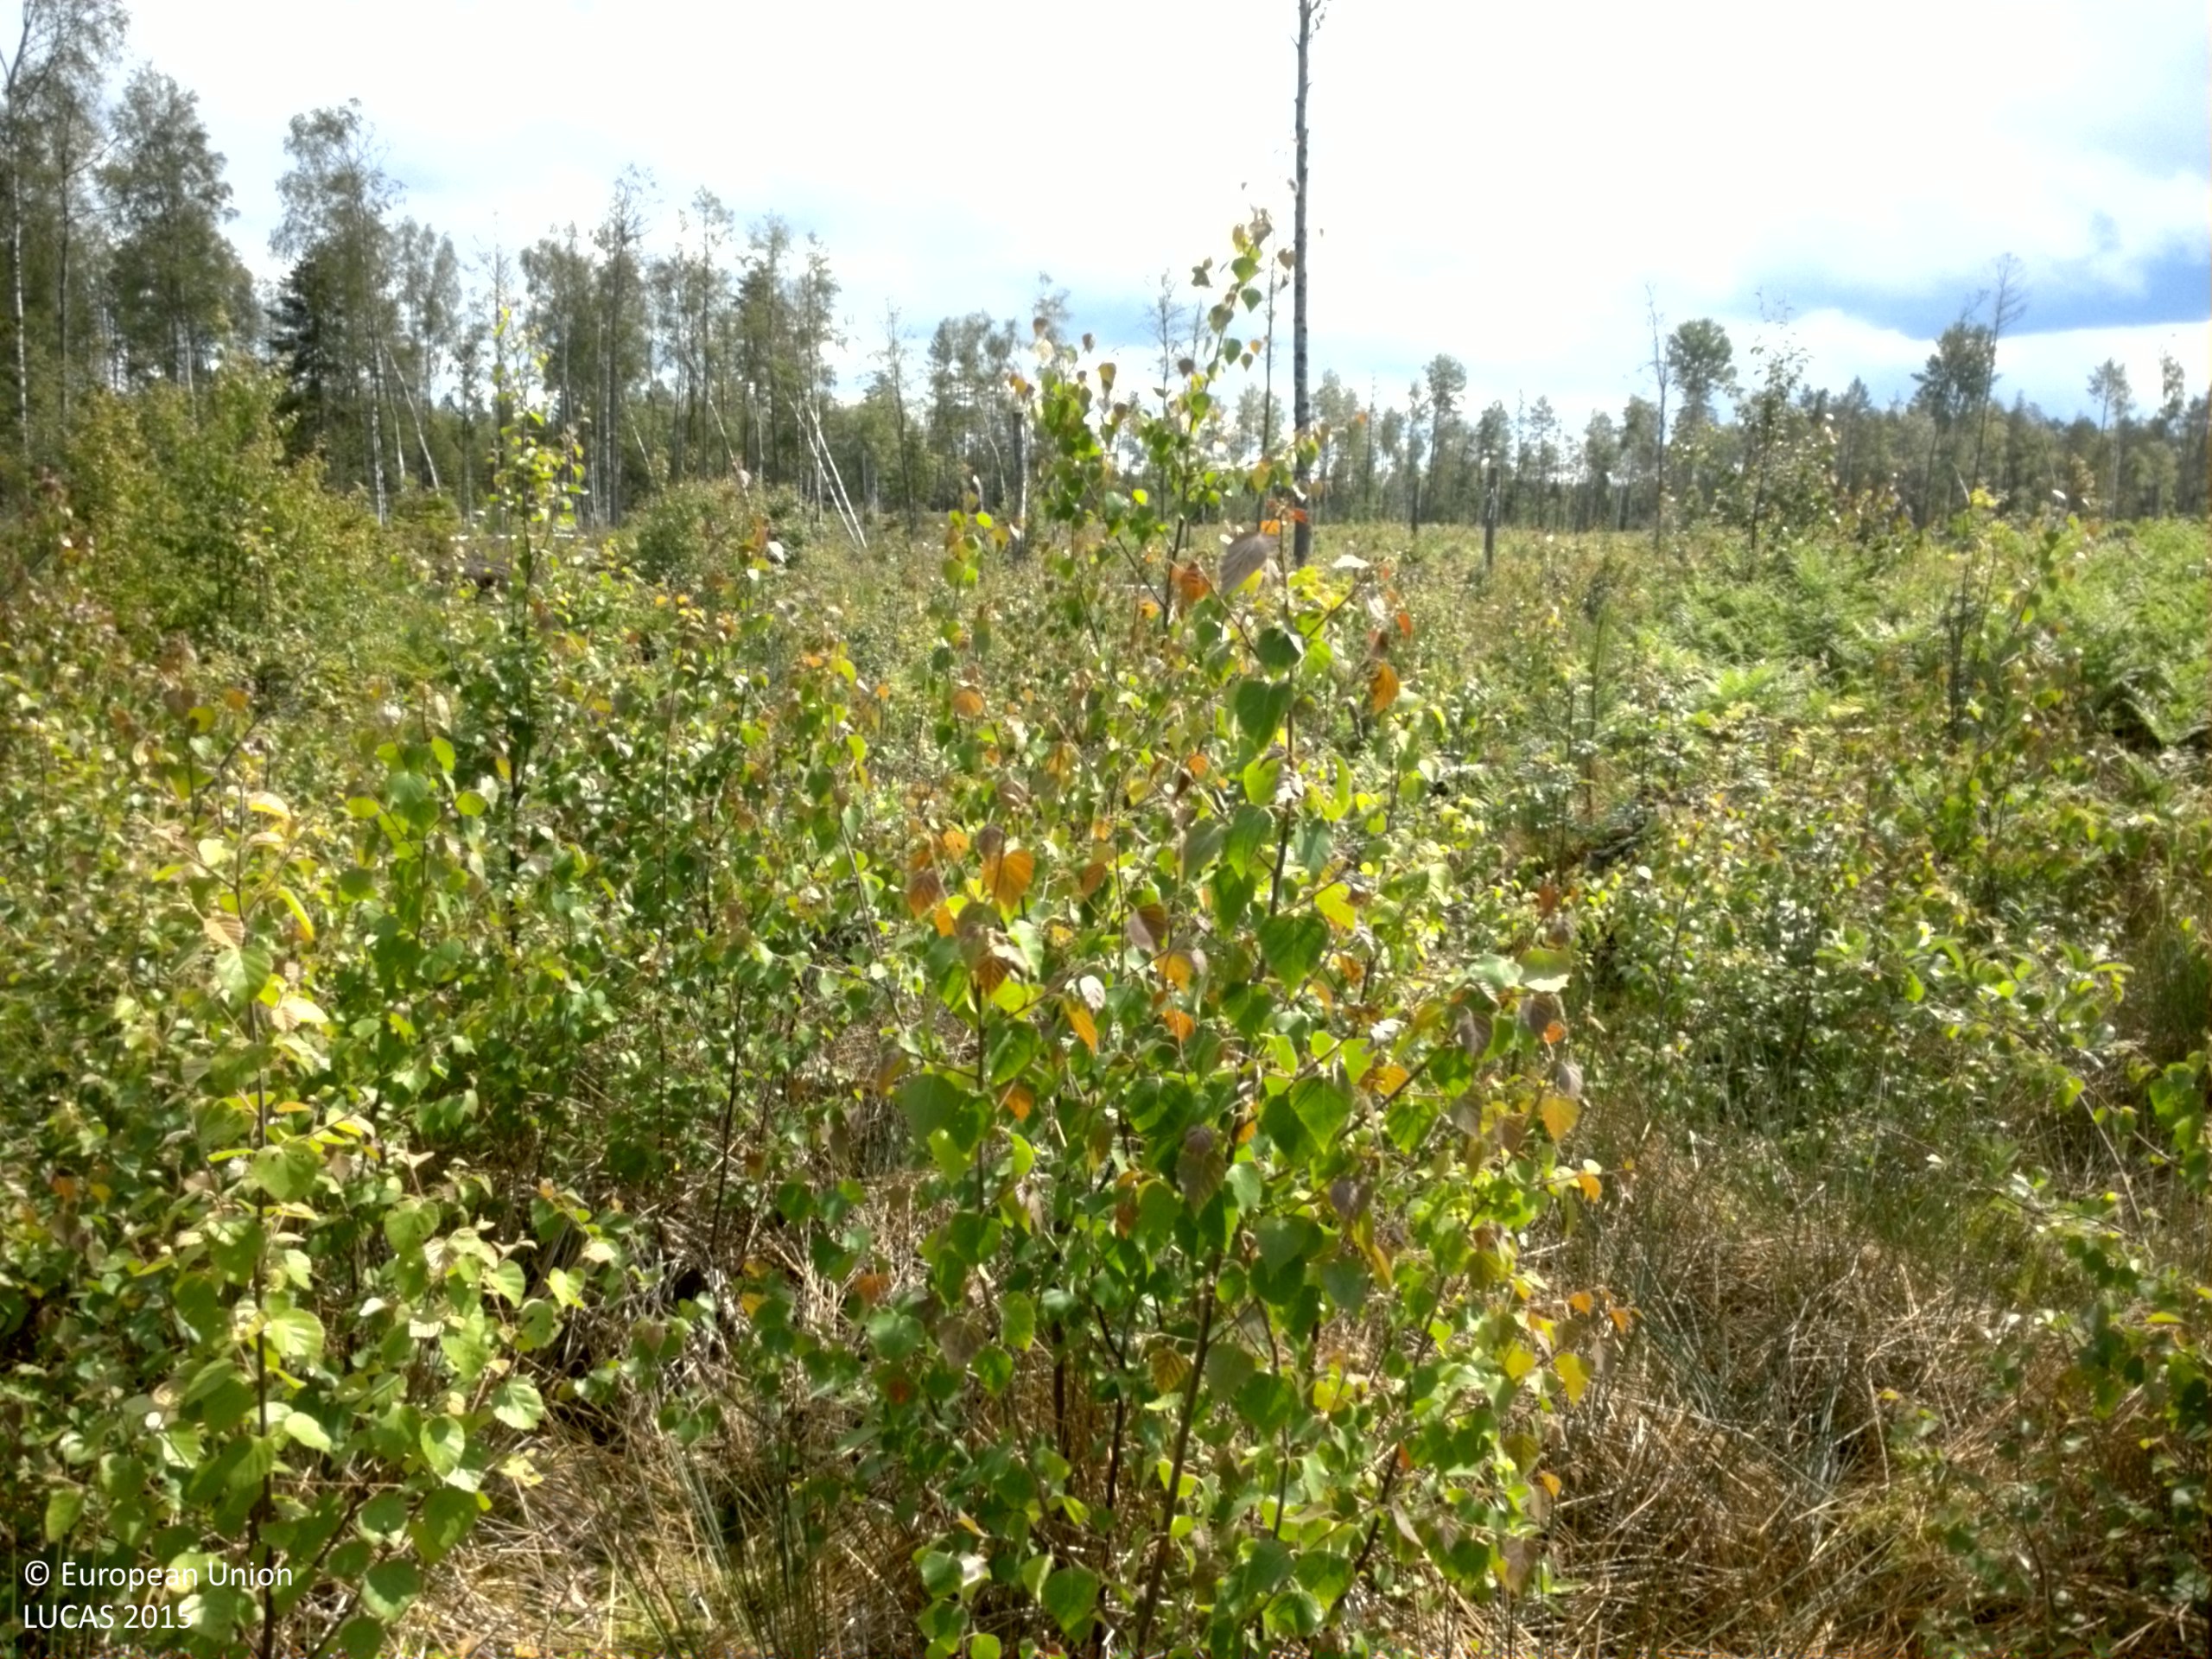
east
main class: Woodland
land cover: Broadleaved woodland
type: boreal forest
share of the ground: 25 - 50 %
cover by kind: herbaceous plants 45 %, broadleaved forest trees 35 %, lichens and mosses 10 %, coniferous forest trees 5 %, shrubs 5 %
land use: Forestry
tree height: < 5 m
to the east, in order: Broadleaved woodland; Ditches and canals; Grassland with sparse tree/shrub cover; Spruce dominated mixed woodland; Spruce dominated coniferous woodland
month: June
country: SE
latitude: 60.4081
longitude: 17.6347
